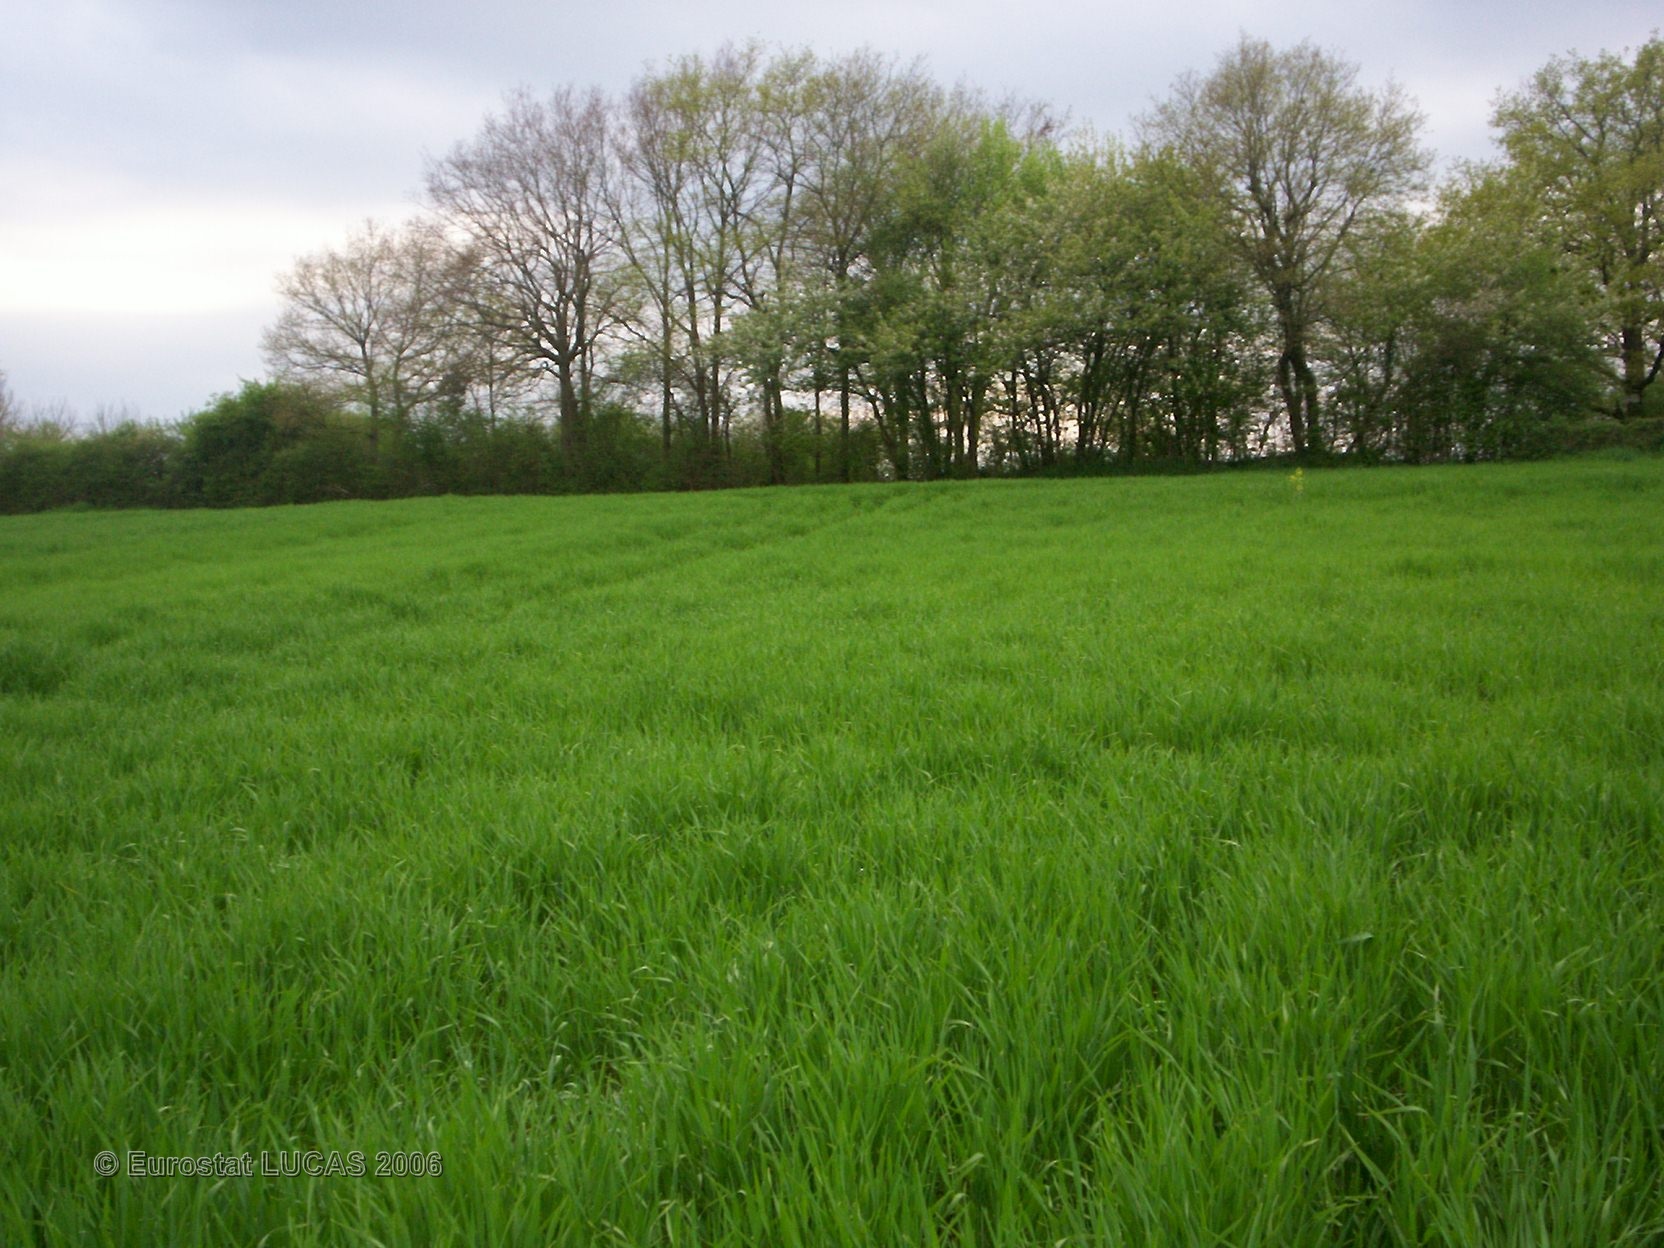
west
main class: Cropland
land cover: Barley
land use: Agriculture (excluding fallow land and kitchen gardens)
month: April
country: FR
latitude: 47.4738
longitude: 2.9485
